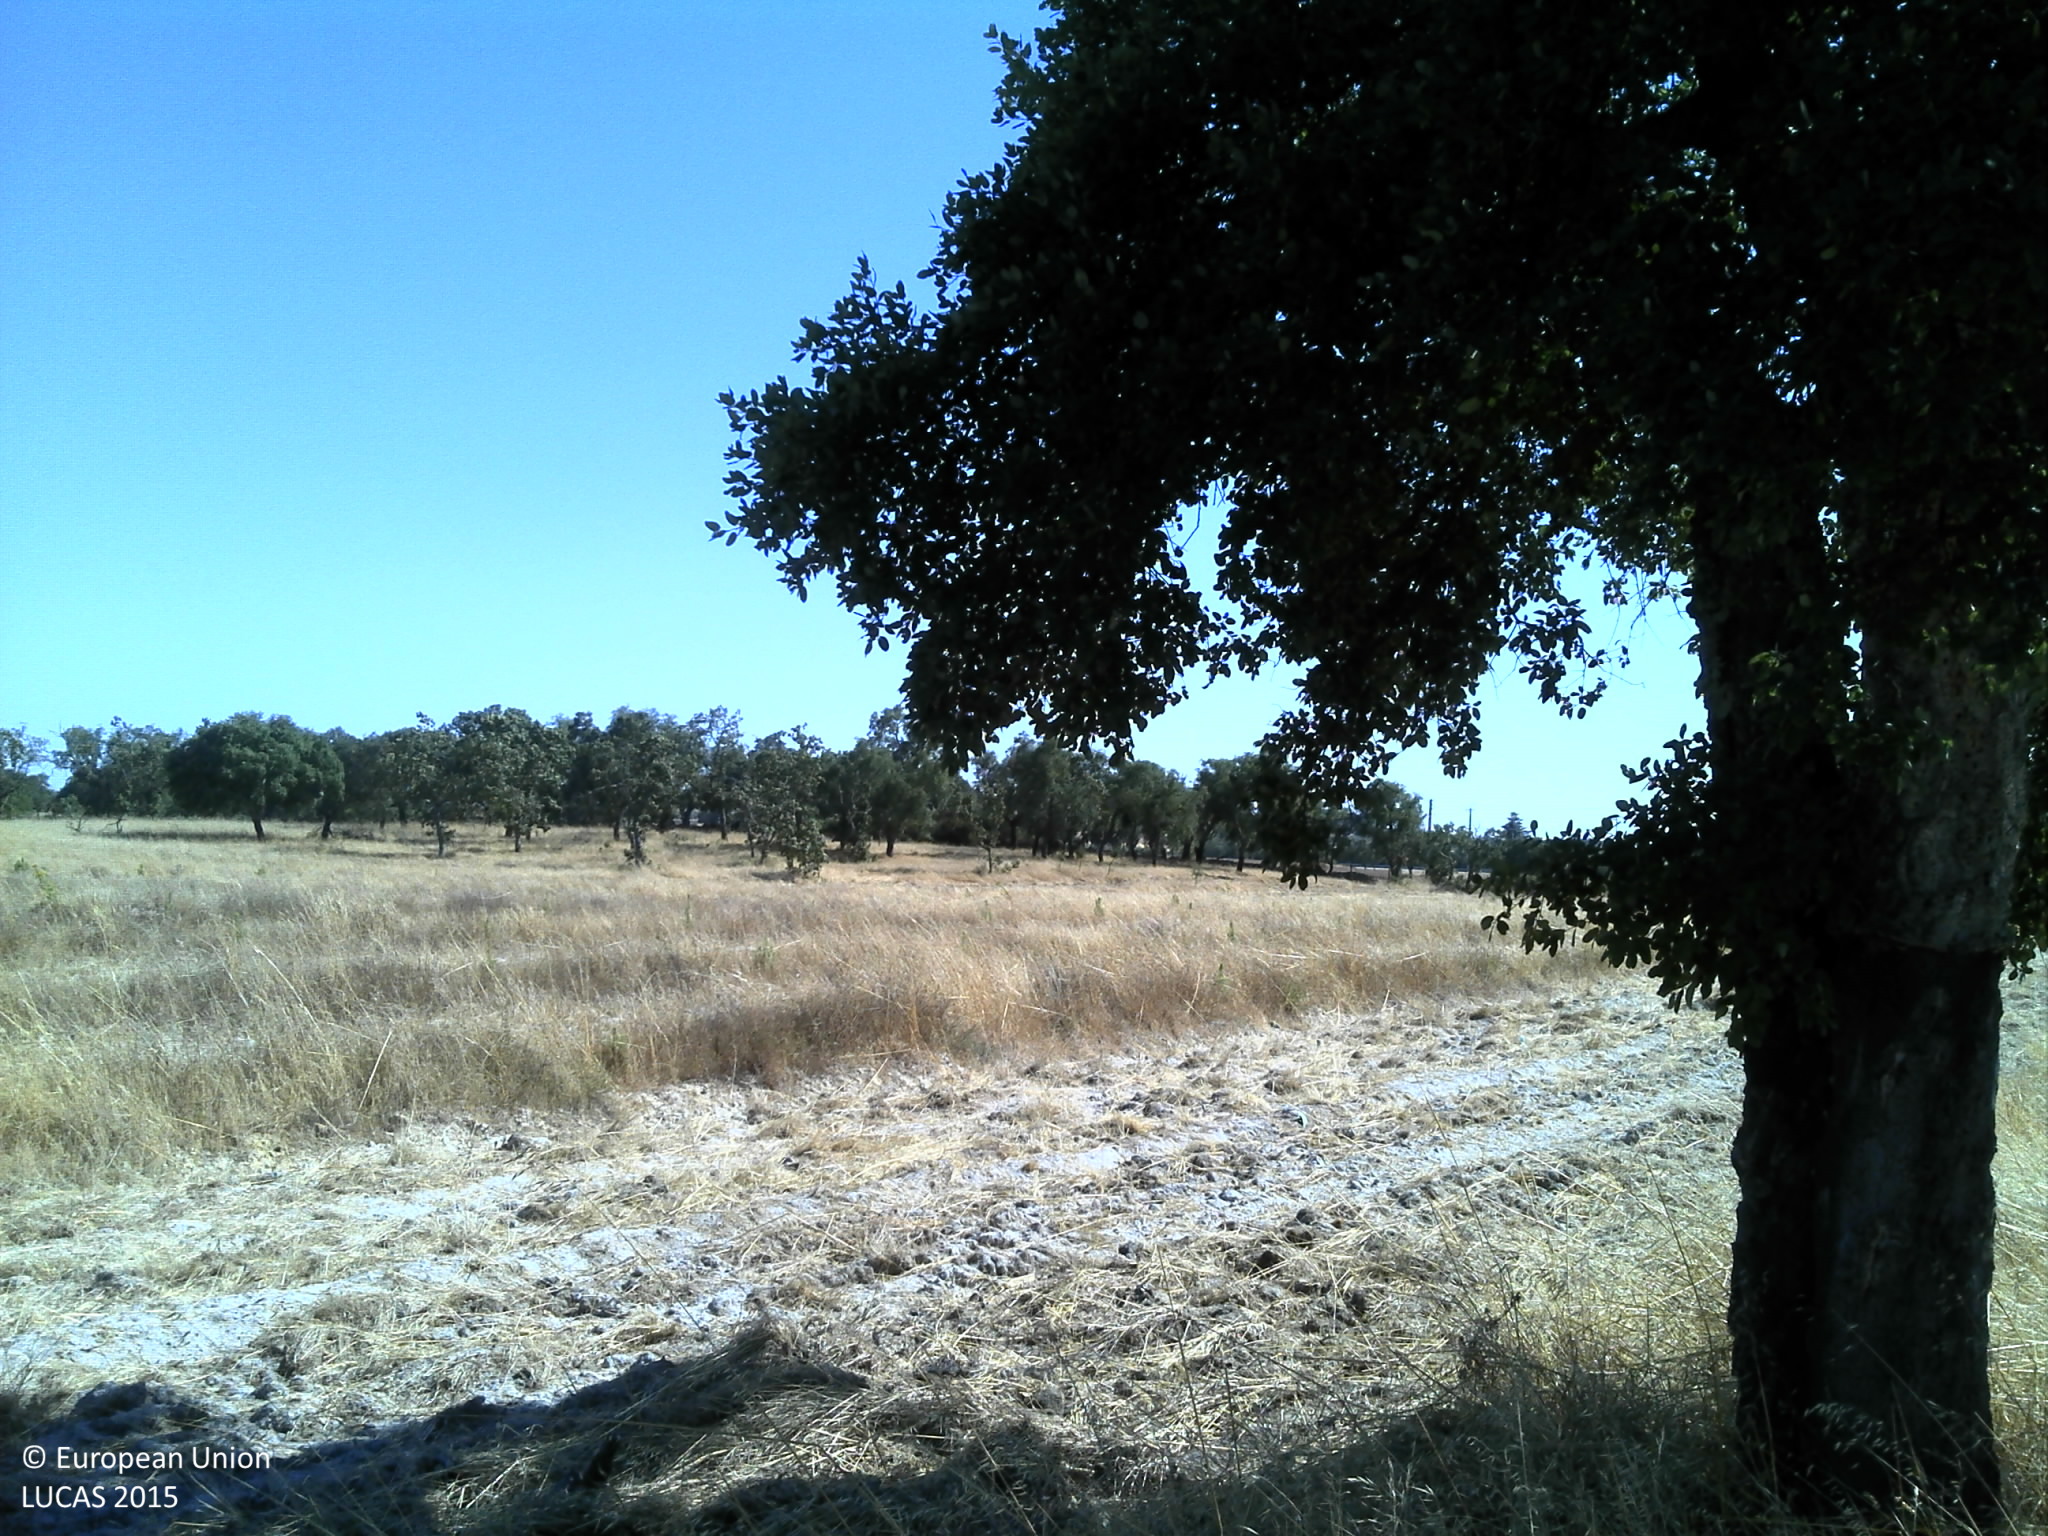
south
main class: Grassland
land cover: Grassland with sparse tree/shrub cover
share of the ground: 10 - 25 %
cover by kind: unconsolidated bare surface 80 %, herbaceous plants 15 %, broadleaved forest trees 5 %
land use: Forestry
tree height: < 5 m
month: July
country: PT
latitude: 39.3190
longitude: -7.6426
